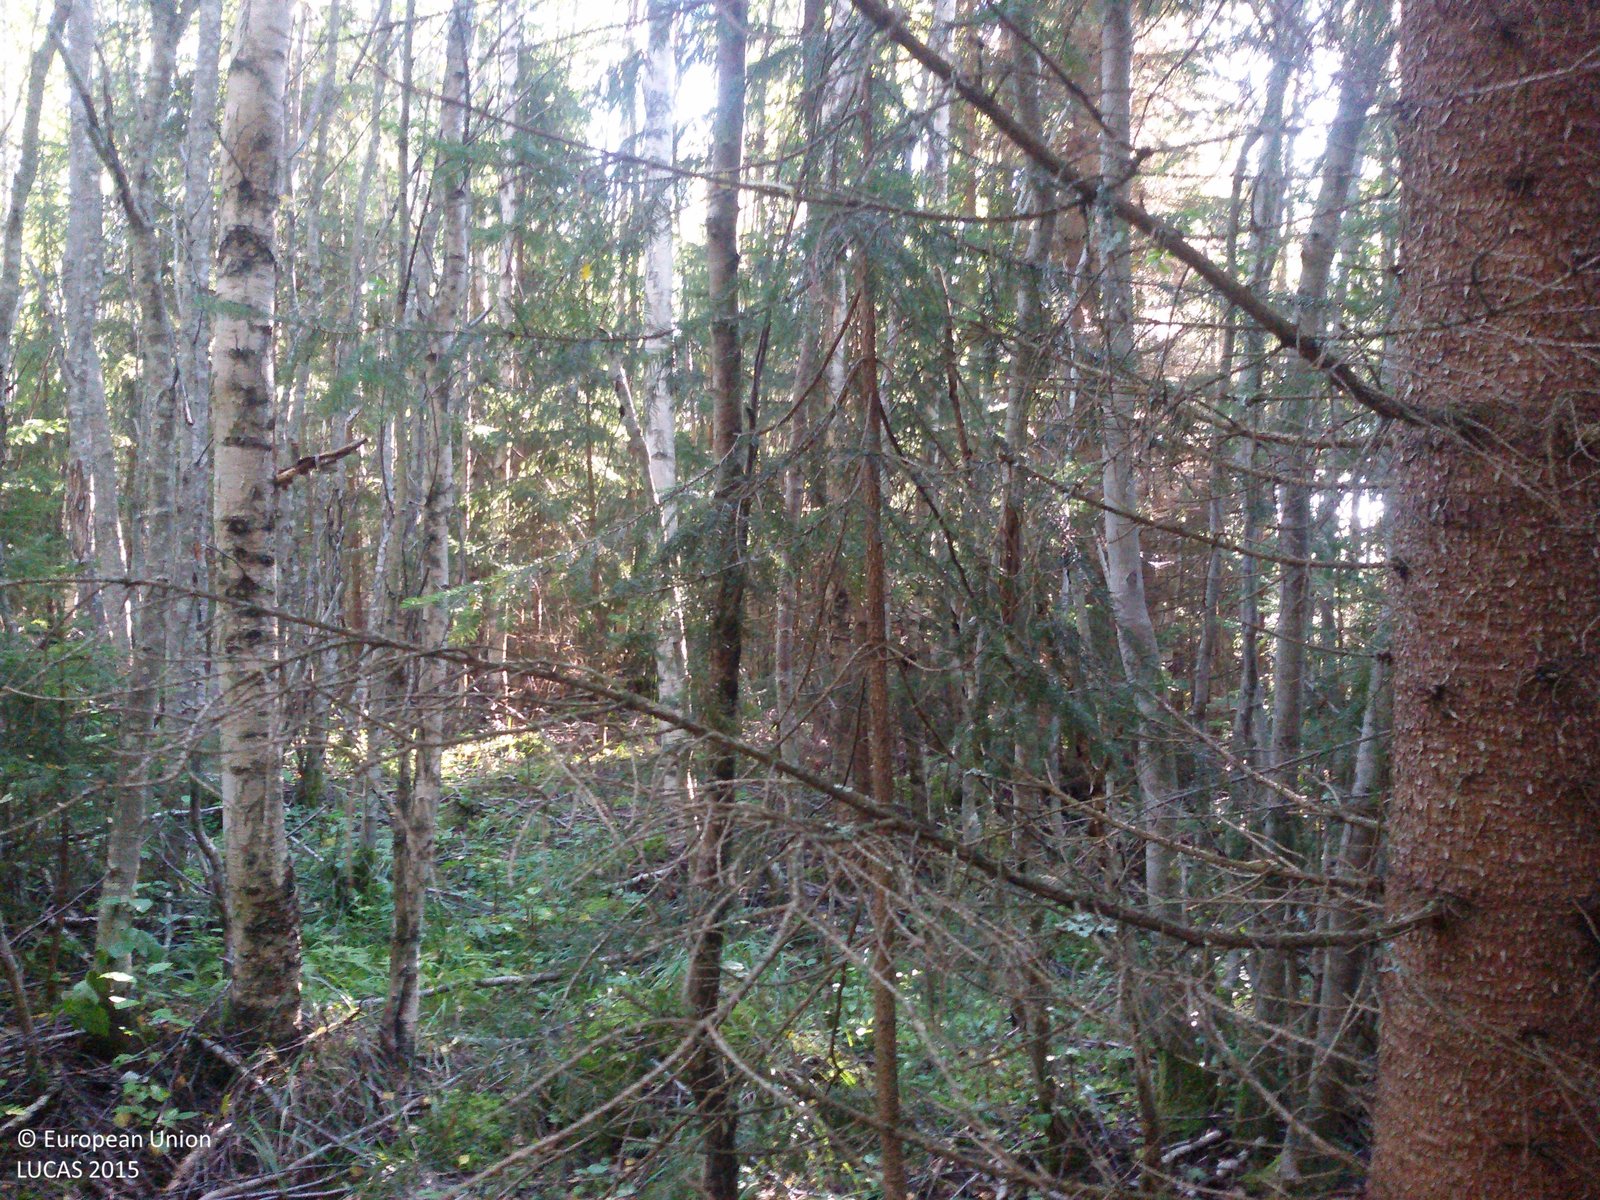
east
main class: Woodland
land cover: Spruce dominated mixed woodland
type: boreal forest
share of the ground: > 75 %
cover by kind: coniferous forest trees 60 %, broadleaved forest trees 20 %, herbaceous plants 10 %, lichens and mosses 10 %
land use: Forestry
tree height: > 5 m
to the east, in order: Spruce dominated mixed woodland; Spruce dominated coniferous woodland; Pine dominated coniferous woodland
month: September
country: SE
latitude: 60.8570
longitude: 15.3064
